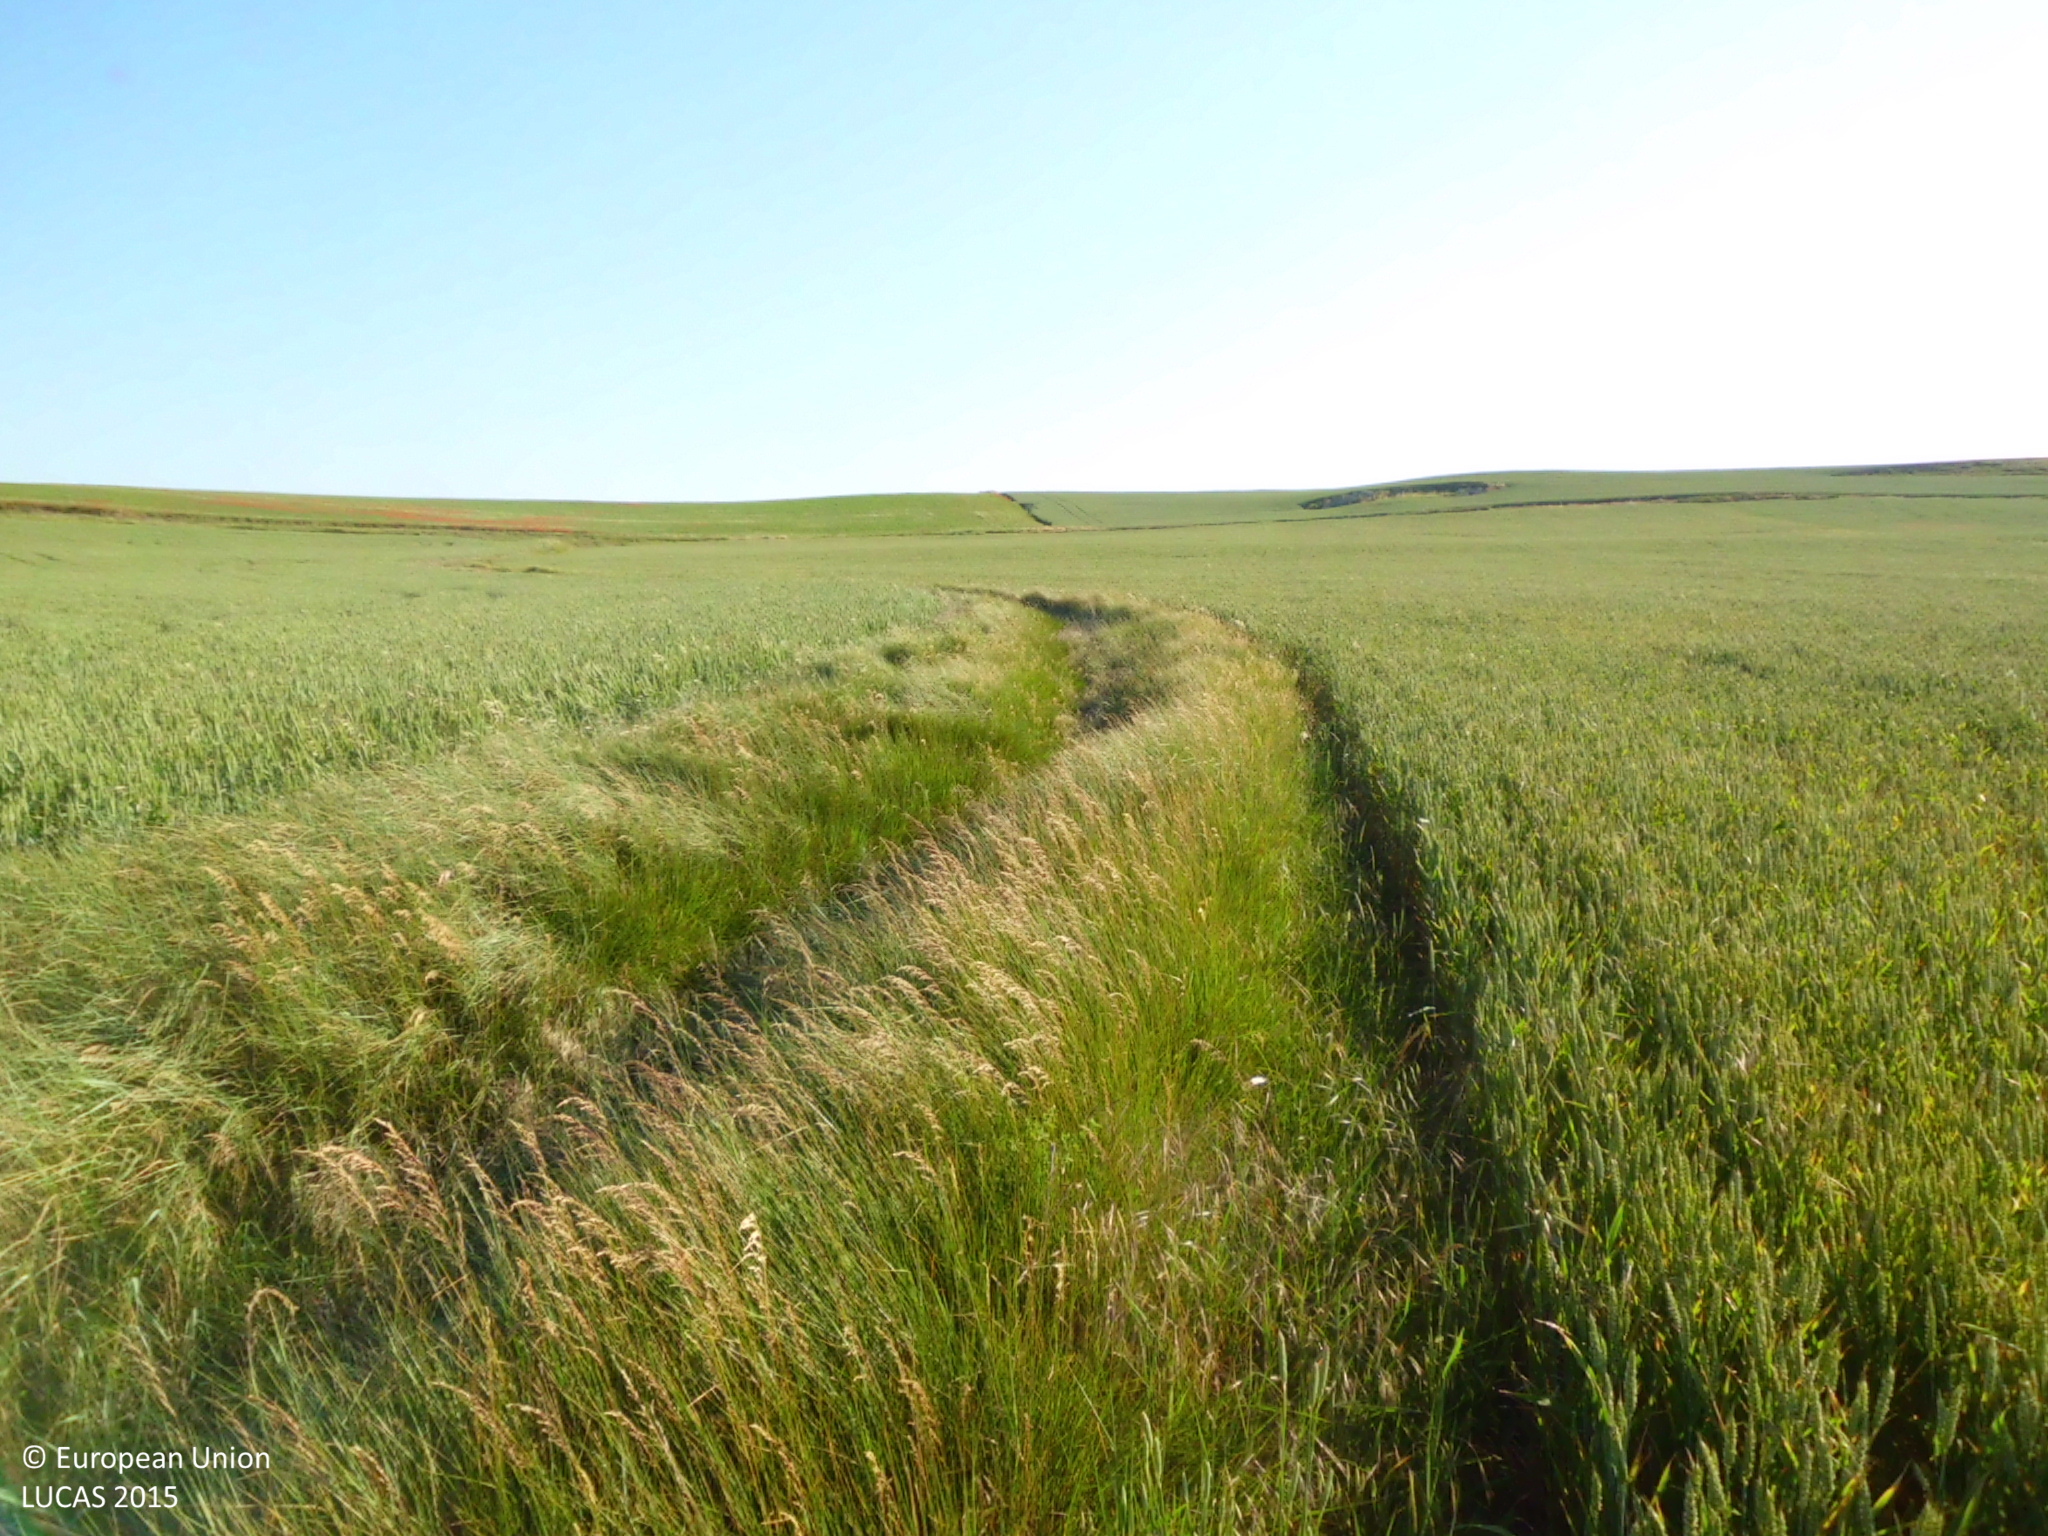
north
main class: Cropland
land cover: Common wheat
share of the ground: > 75 %
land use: Agriculture (excluding fallow land and kitchen gardens)
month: June
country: ES
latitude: 42.3548
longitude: -3.9903
